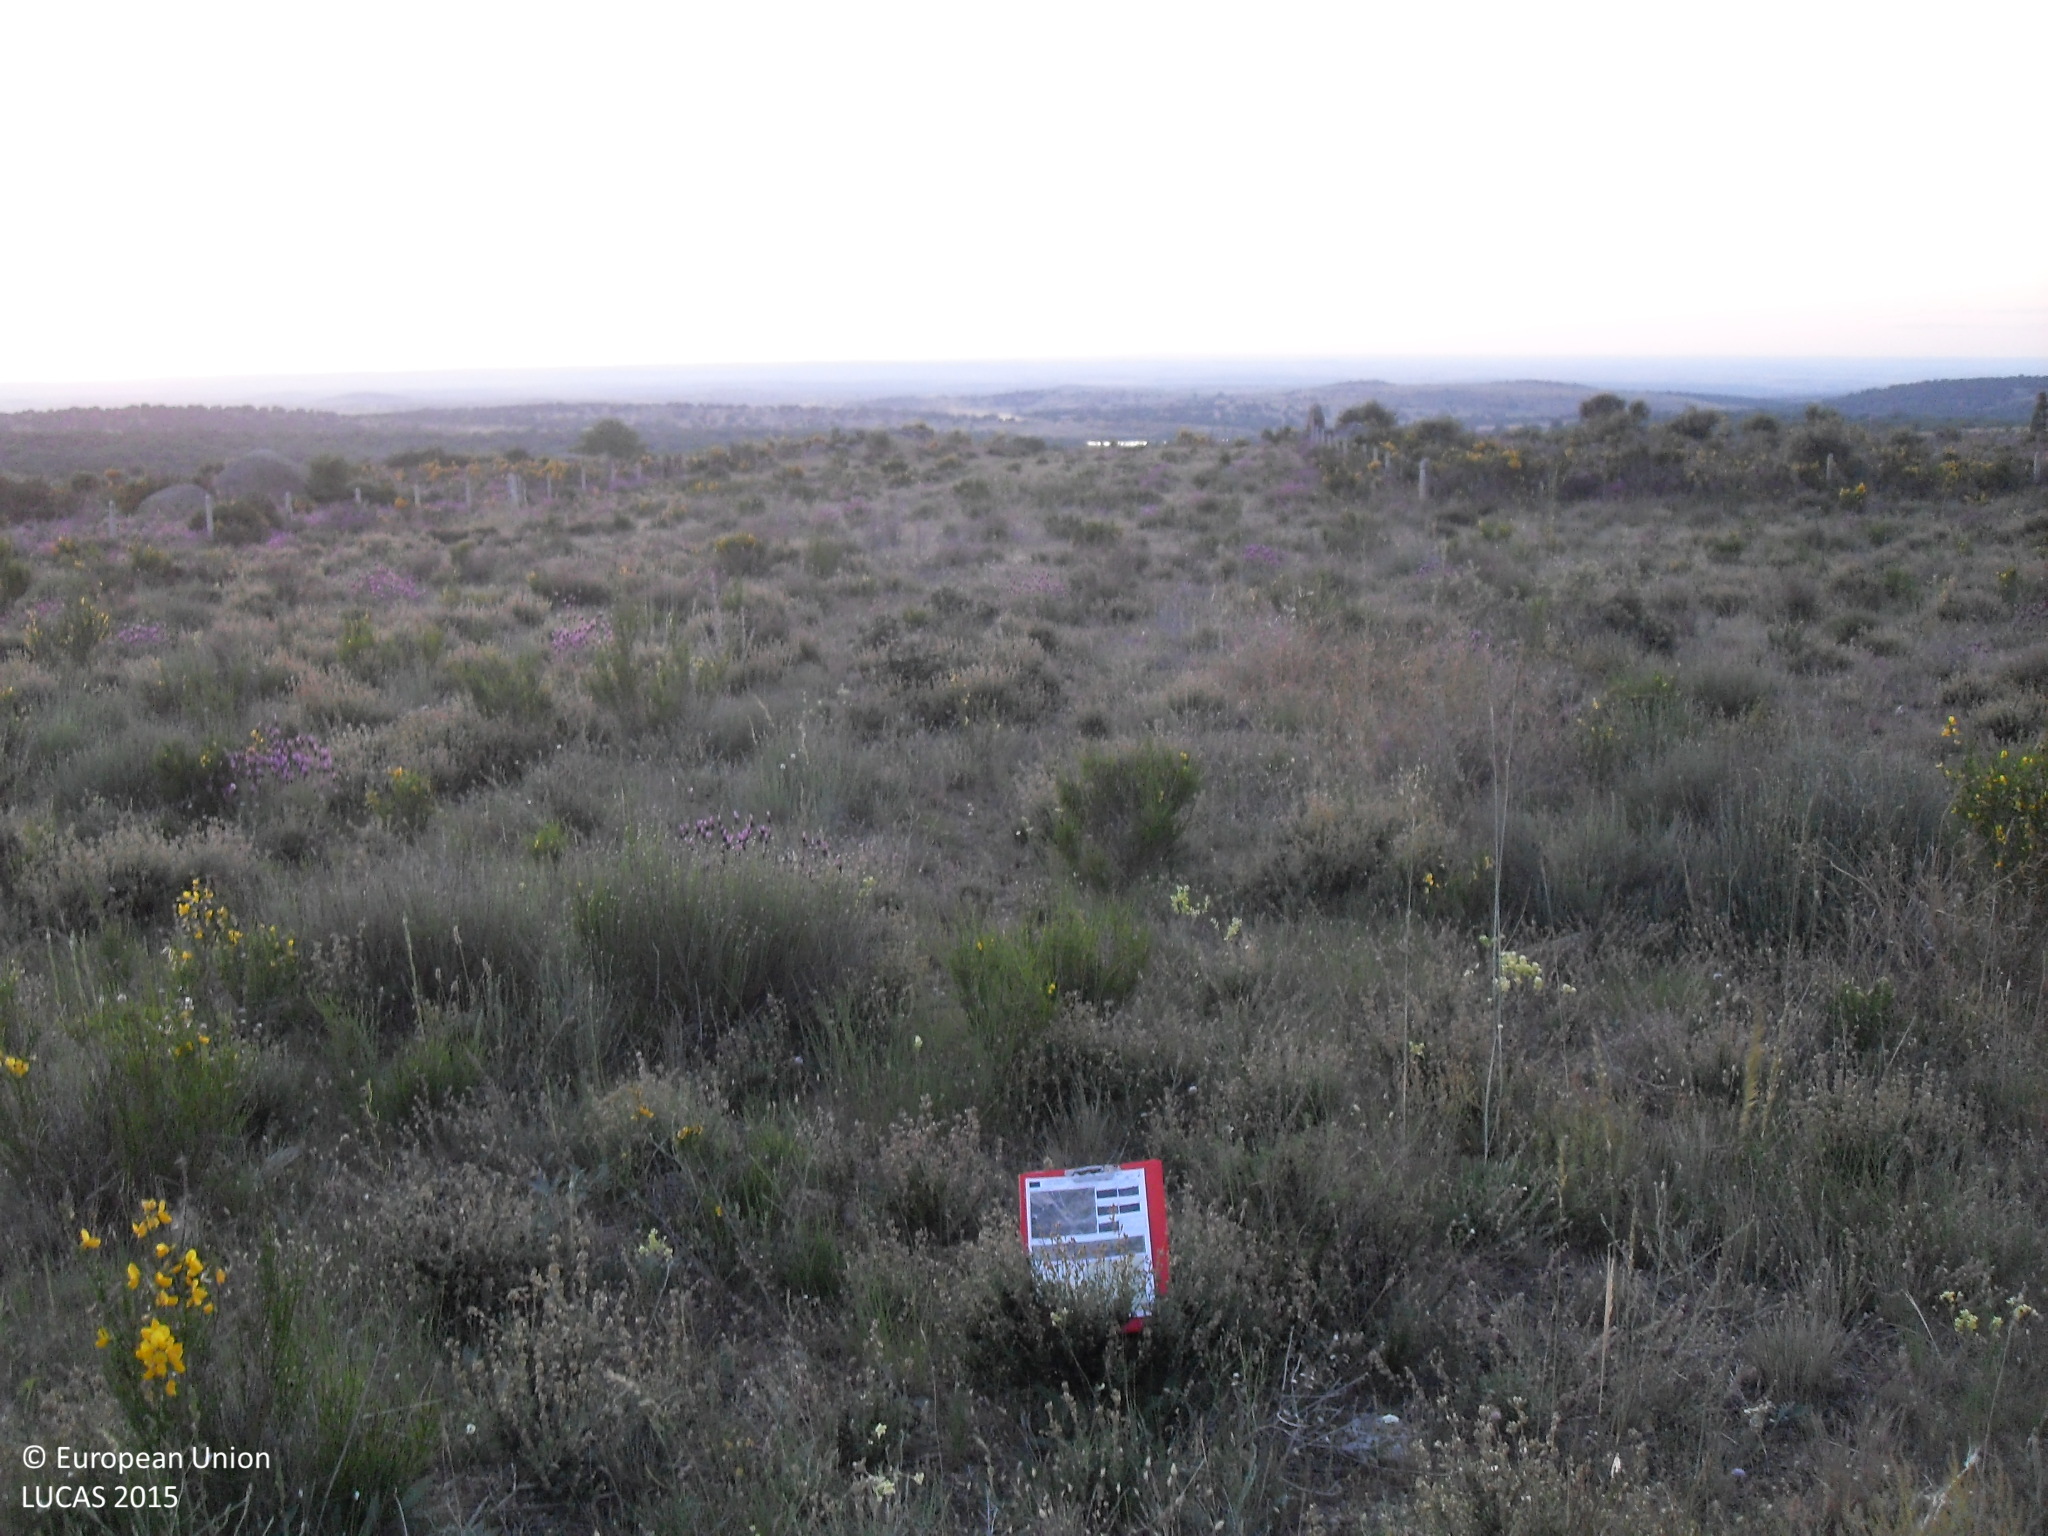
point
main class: Grassland
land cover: Grassland without tree/shrub cover
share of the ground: > 75 %
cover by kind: herbaceous plants 100 %
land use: Agriculture (excluding fallow land and kitchen gardens)
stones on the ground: < 10 %
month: May
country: ES
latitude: 40.5674
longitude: -5.2896
